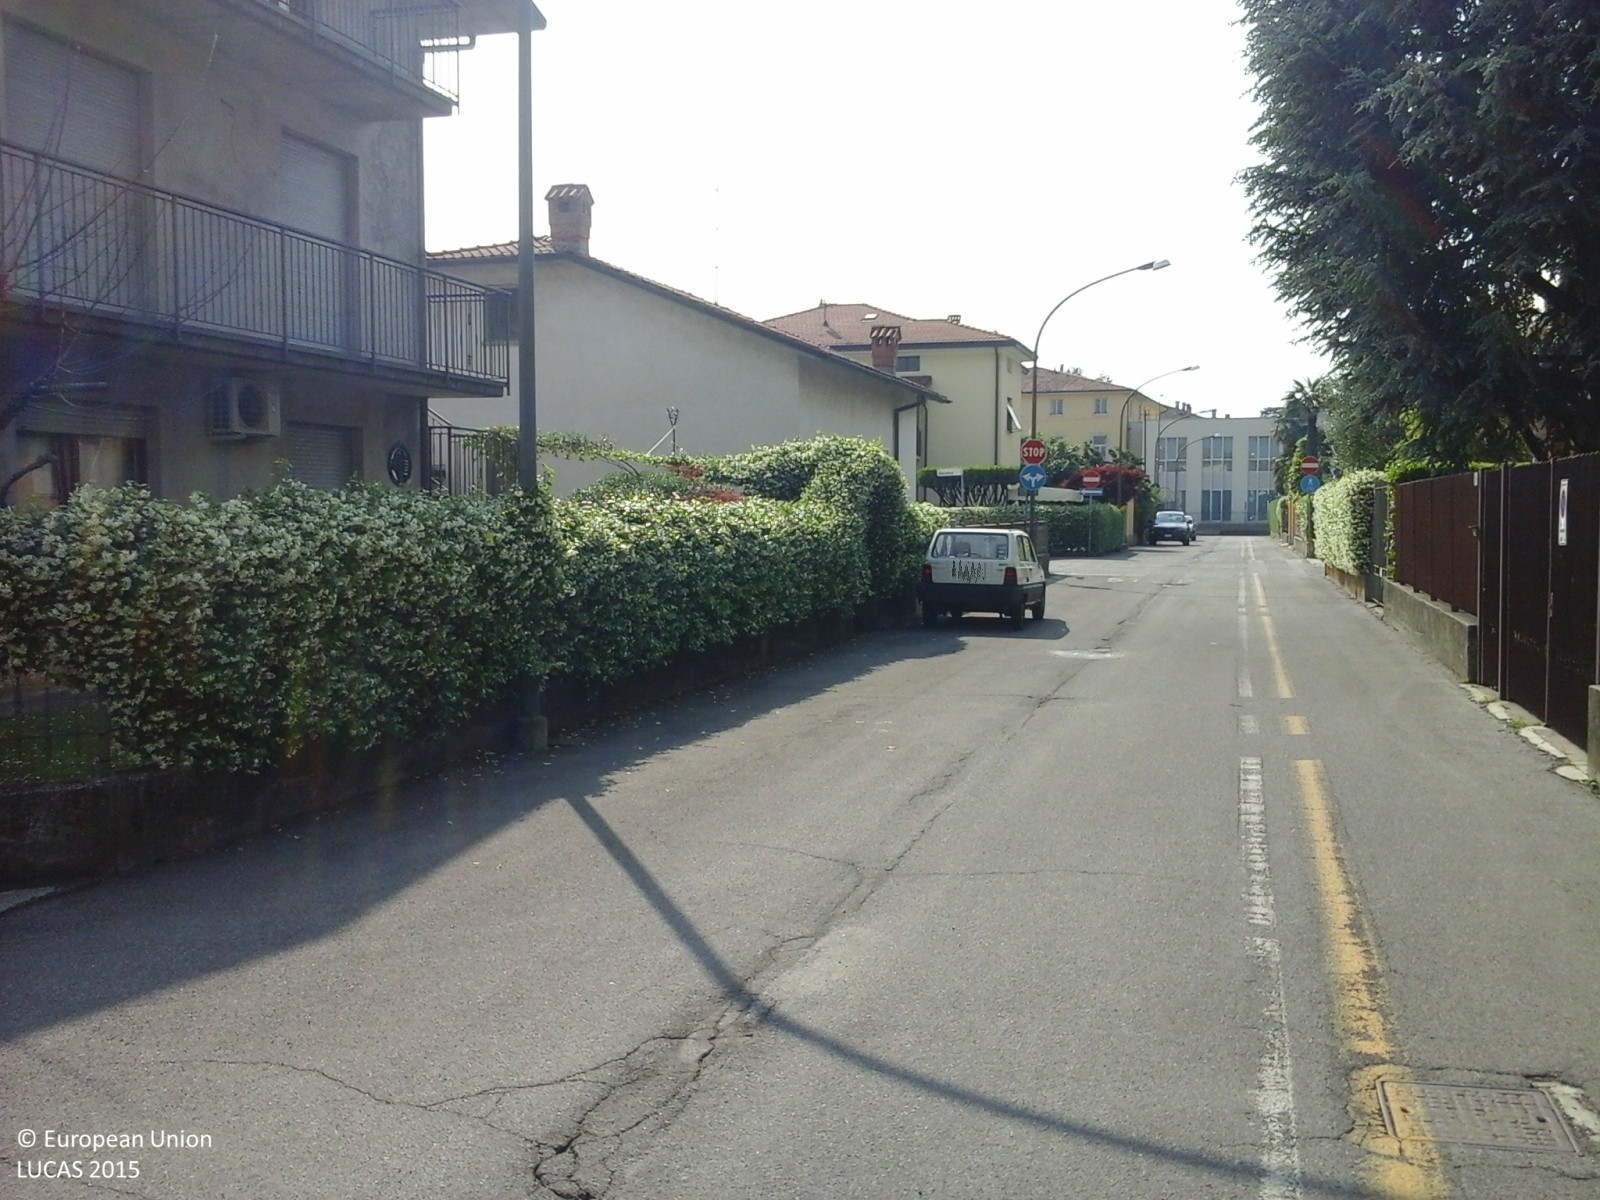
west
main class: Grassland
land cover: Grassland with sparse tree/shrub cover
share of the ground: > 75 %
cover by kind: herbaceous plants 90 %, broadleaved forest trees 5 %, shrubs 5 %
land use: Residential
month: May
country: IT
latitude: 45.6480
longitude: 9.6541
